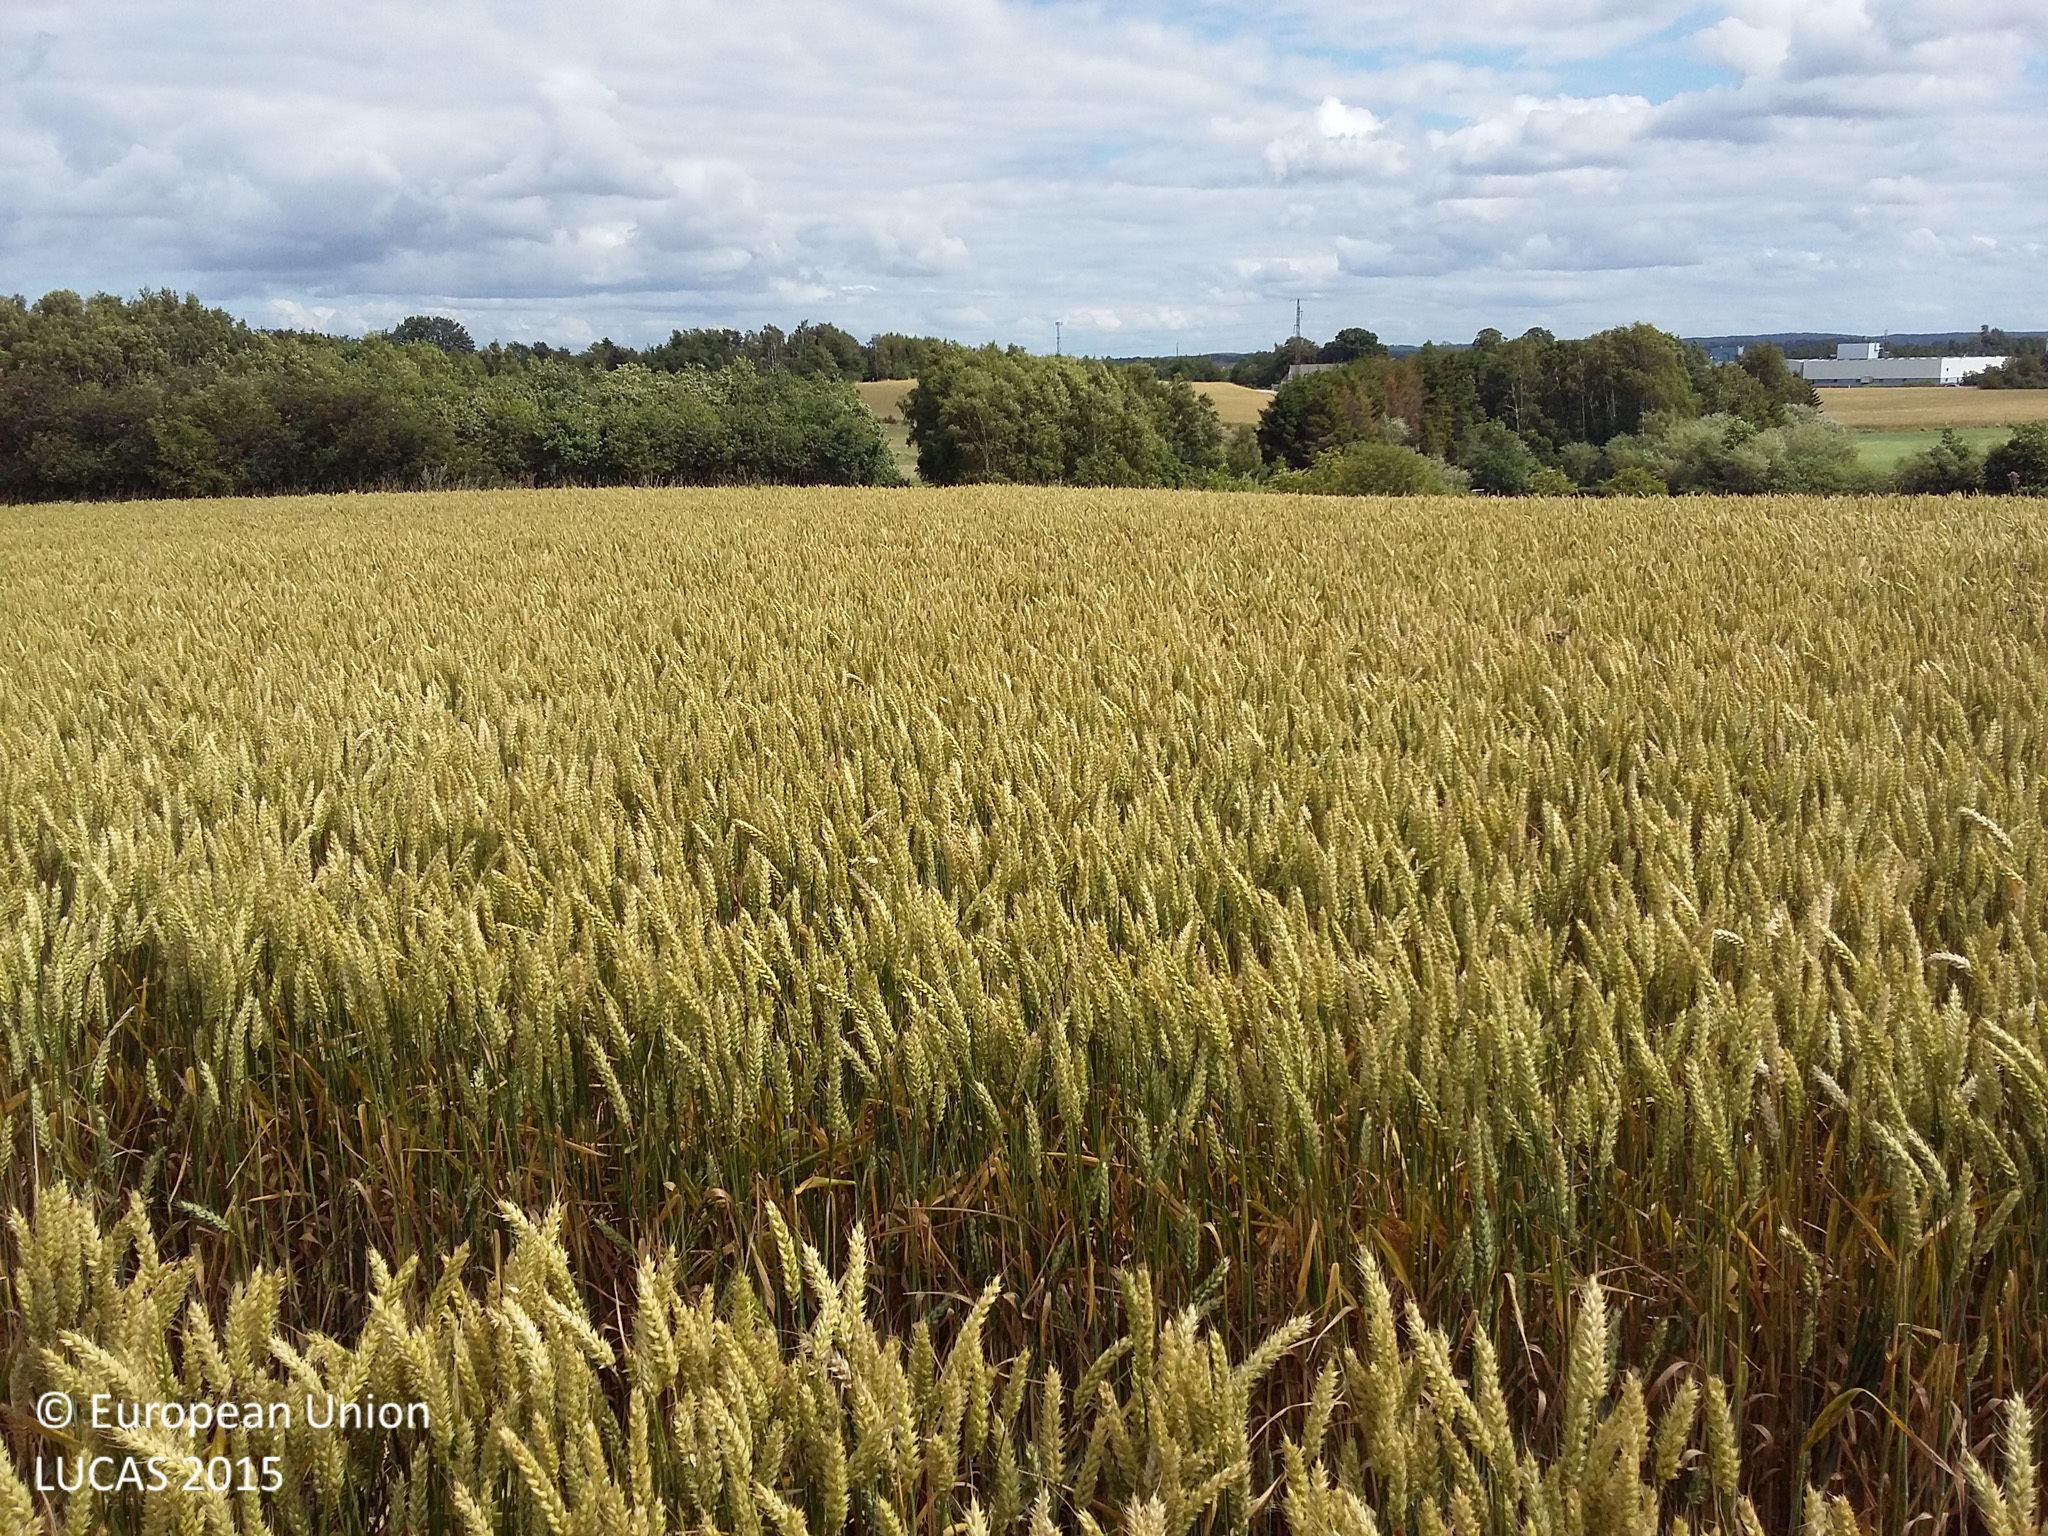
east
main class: Cropland
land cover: Common wheat
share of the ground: > 75 %
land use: Agriculture (excluding fallow land and kitchen gardens)
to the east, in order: Common wheat; Grassland without tree/shrub cover; Temporary grasslands; Broadleaved woodland; Grassland with sparse tree/shrub cover; Temporary grasslands
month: July
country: DK
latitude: 56.0257
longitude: 12.1640
